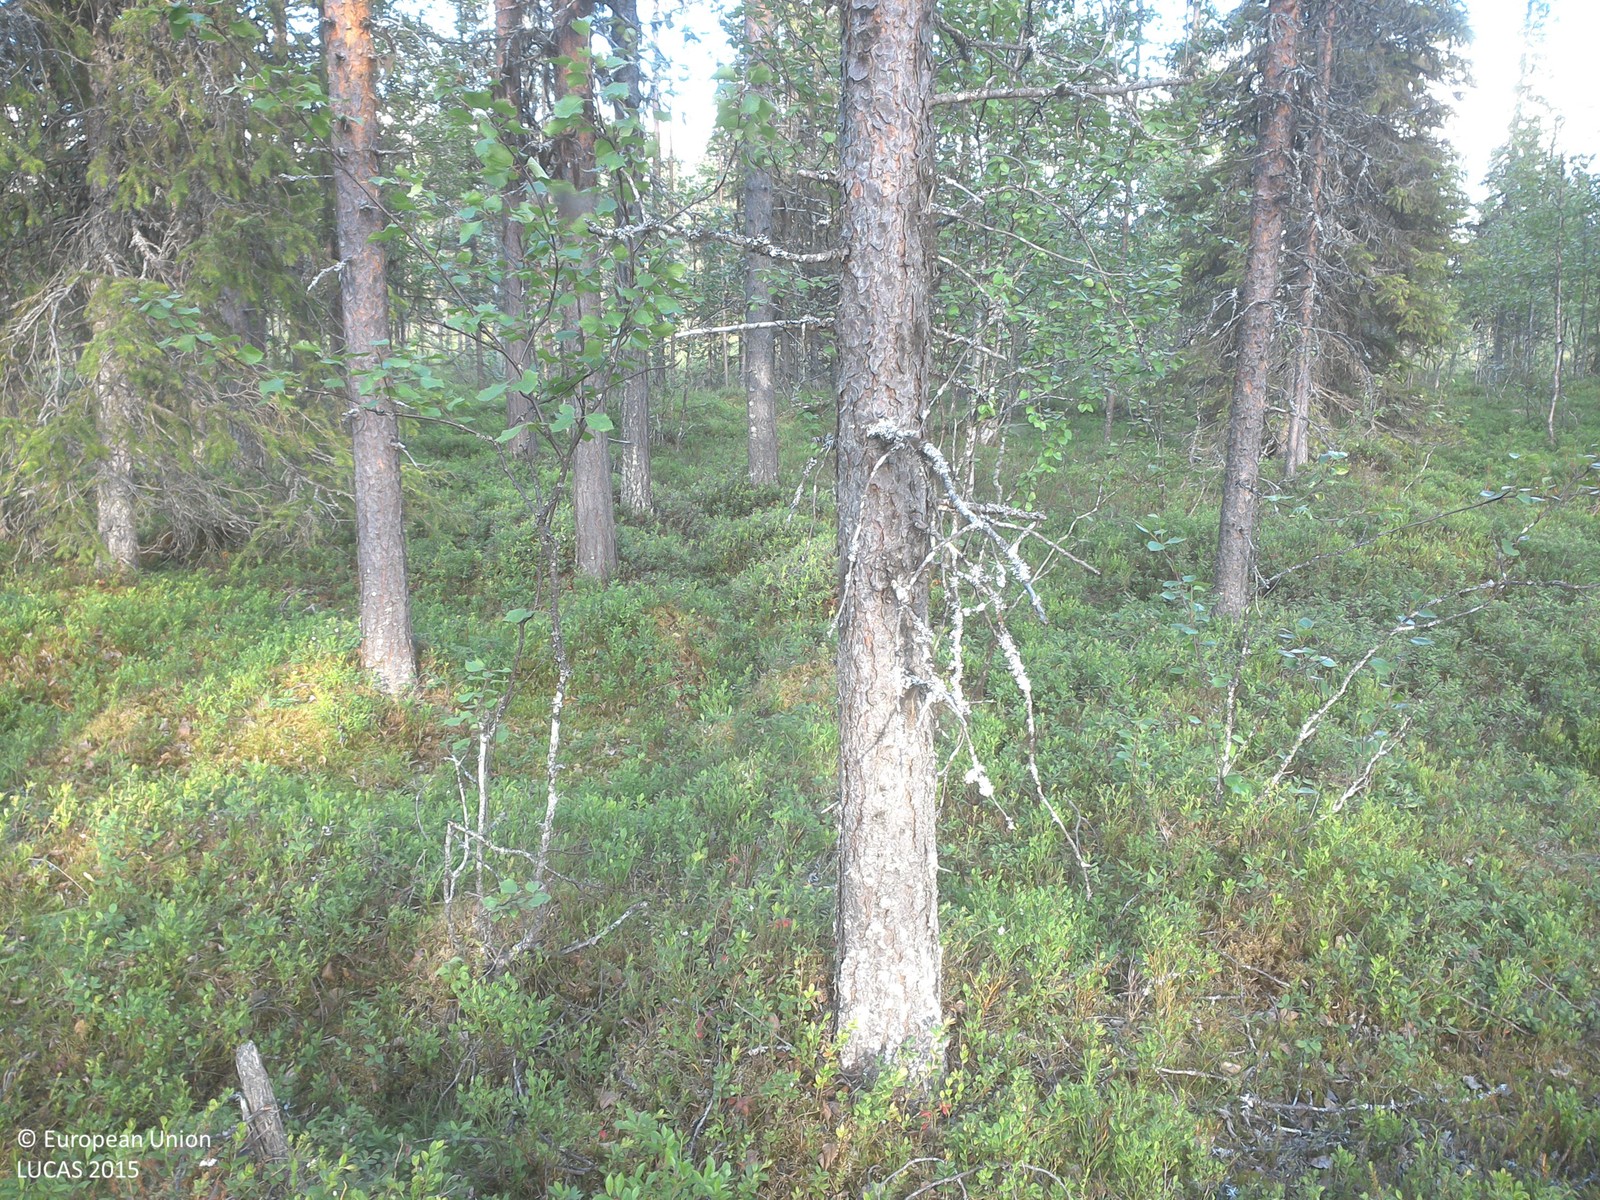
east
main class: Woodland
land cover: Pine dominated mixed woodland
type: boreal forest
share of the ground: 25 - 50 %
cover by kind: shrubs 60 %, coniferous forest trees 20 %, broadleaved forest trees 15 %, lichens and mosses 5 %
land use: Forestry
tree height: > 5 m
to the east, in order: Pine dominated mixed woodland; Pine dominated coniferous woodland; Groves; Ditches and canals; Paved roads, cycling and walking lanes; Groves; Ditches and canals; Pine dominated mixed woodland; Pine dominated coniferous woodland
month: July
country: SE
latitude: 67.4347
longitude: 23.1599
